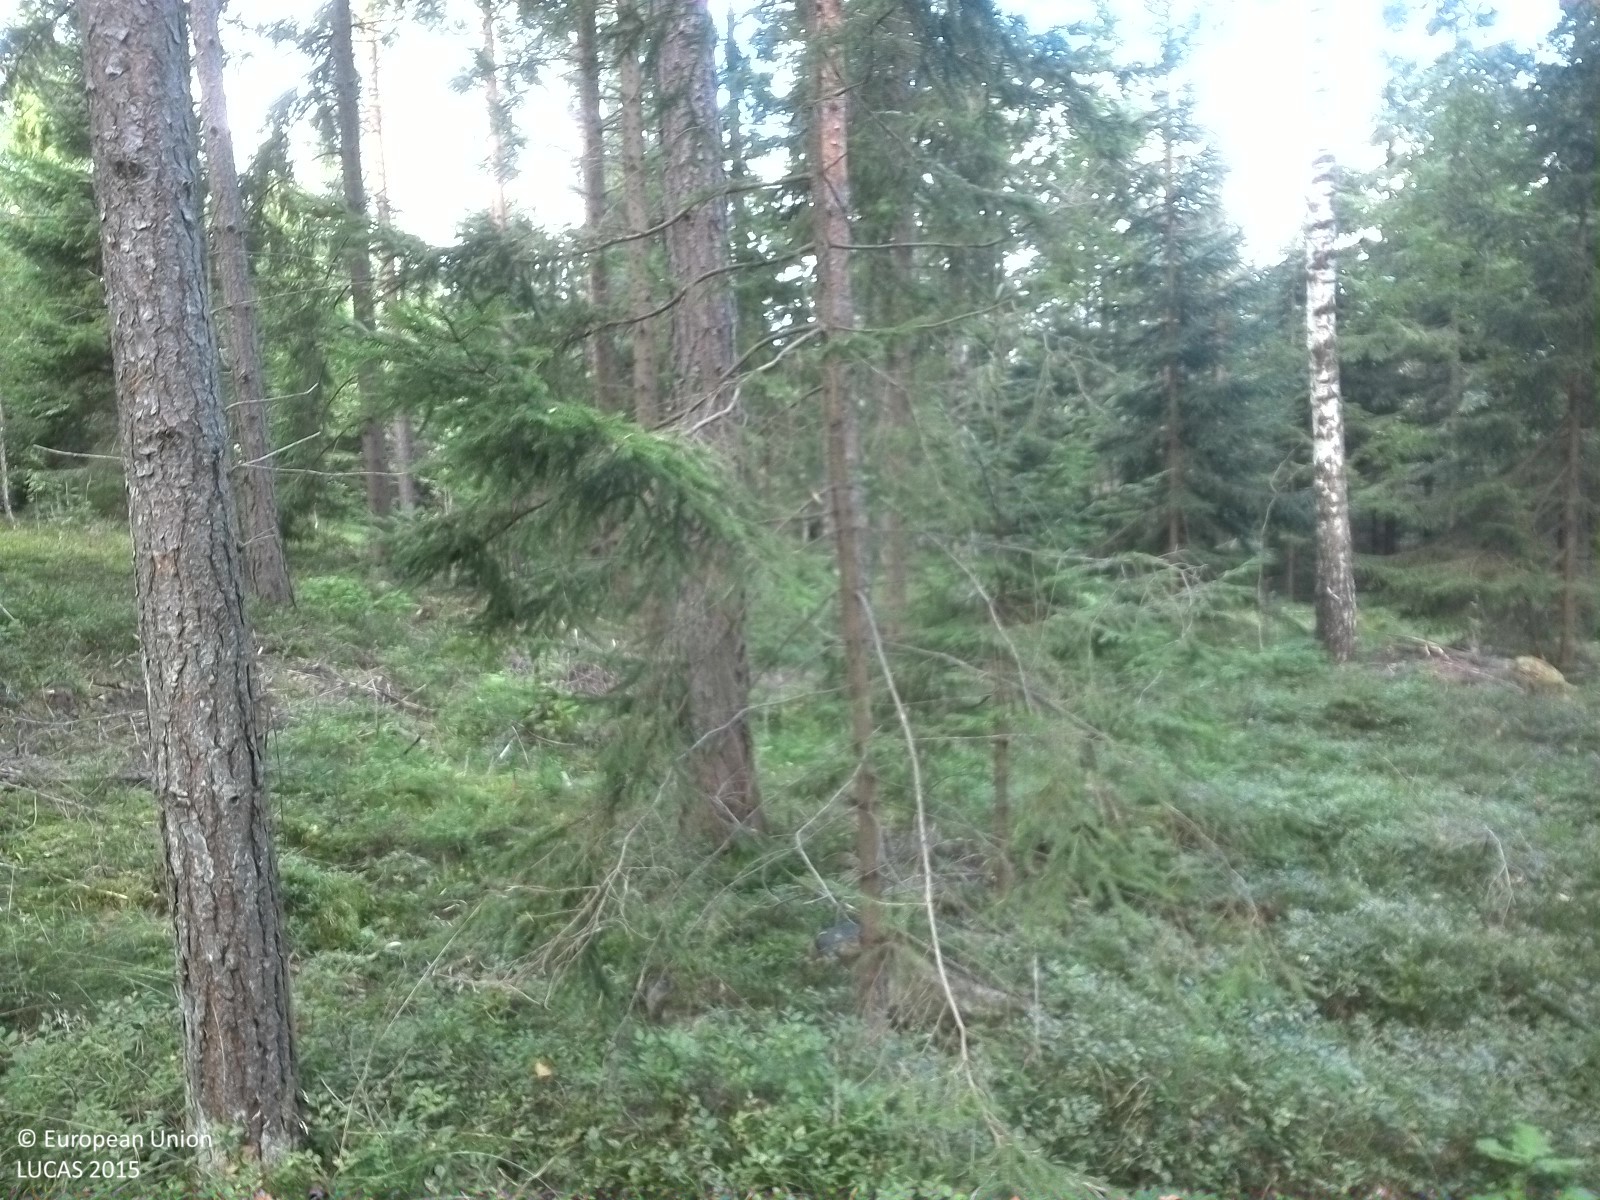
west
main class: Woodland
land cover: Pine dominated coniferous woodland
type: boreal forest
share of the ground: 25 - 50 %
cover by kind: herbaceous plants 50 %, coniferous forest trees 25 %, lichens and mosses 20 %, broadleaved forest trees 5 %
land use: Forestry
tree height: > 5 m
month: August
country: SE
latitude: 59.1131
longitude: 15.5986
